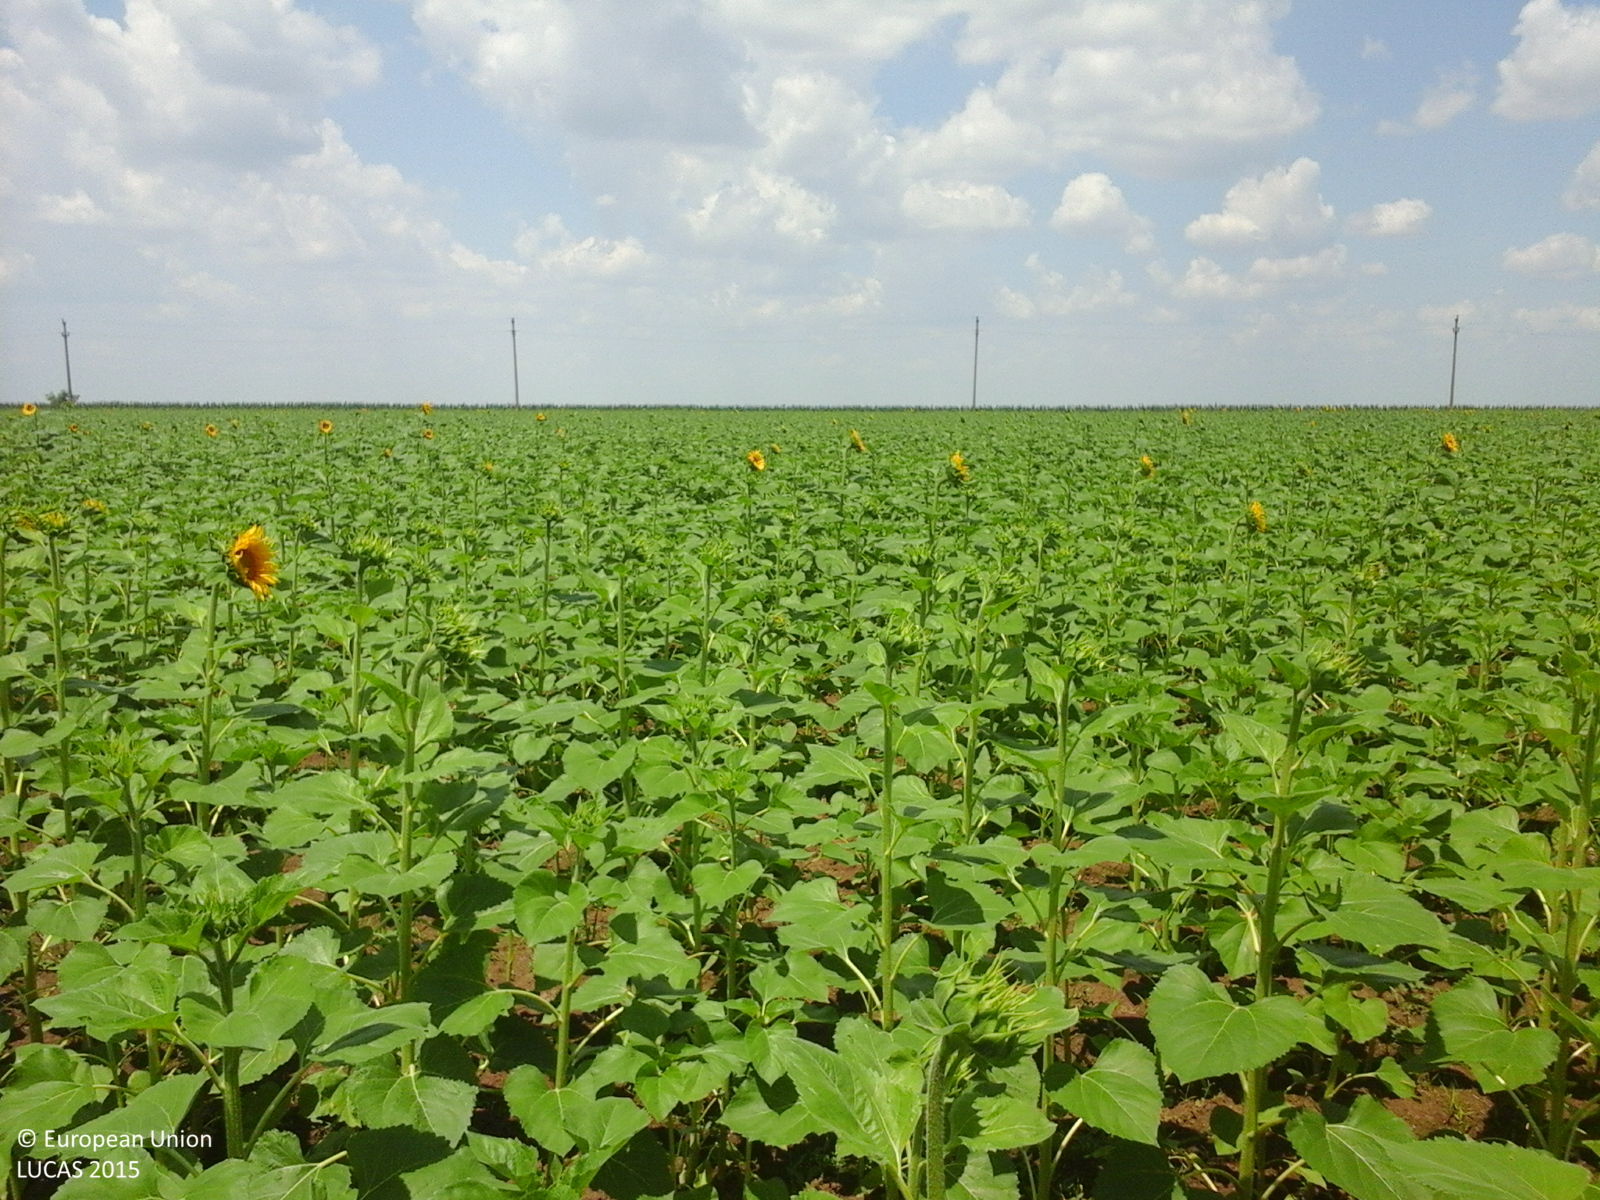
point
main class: Cropland
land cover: Sunflower
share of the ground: > 75 %
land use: Agriculture (excluding fallow land and kitchen gardens)
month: July
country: RO
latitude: 44.1013
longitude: 25.2096
